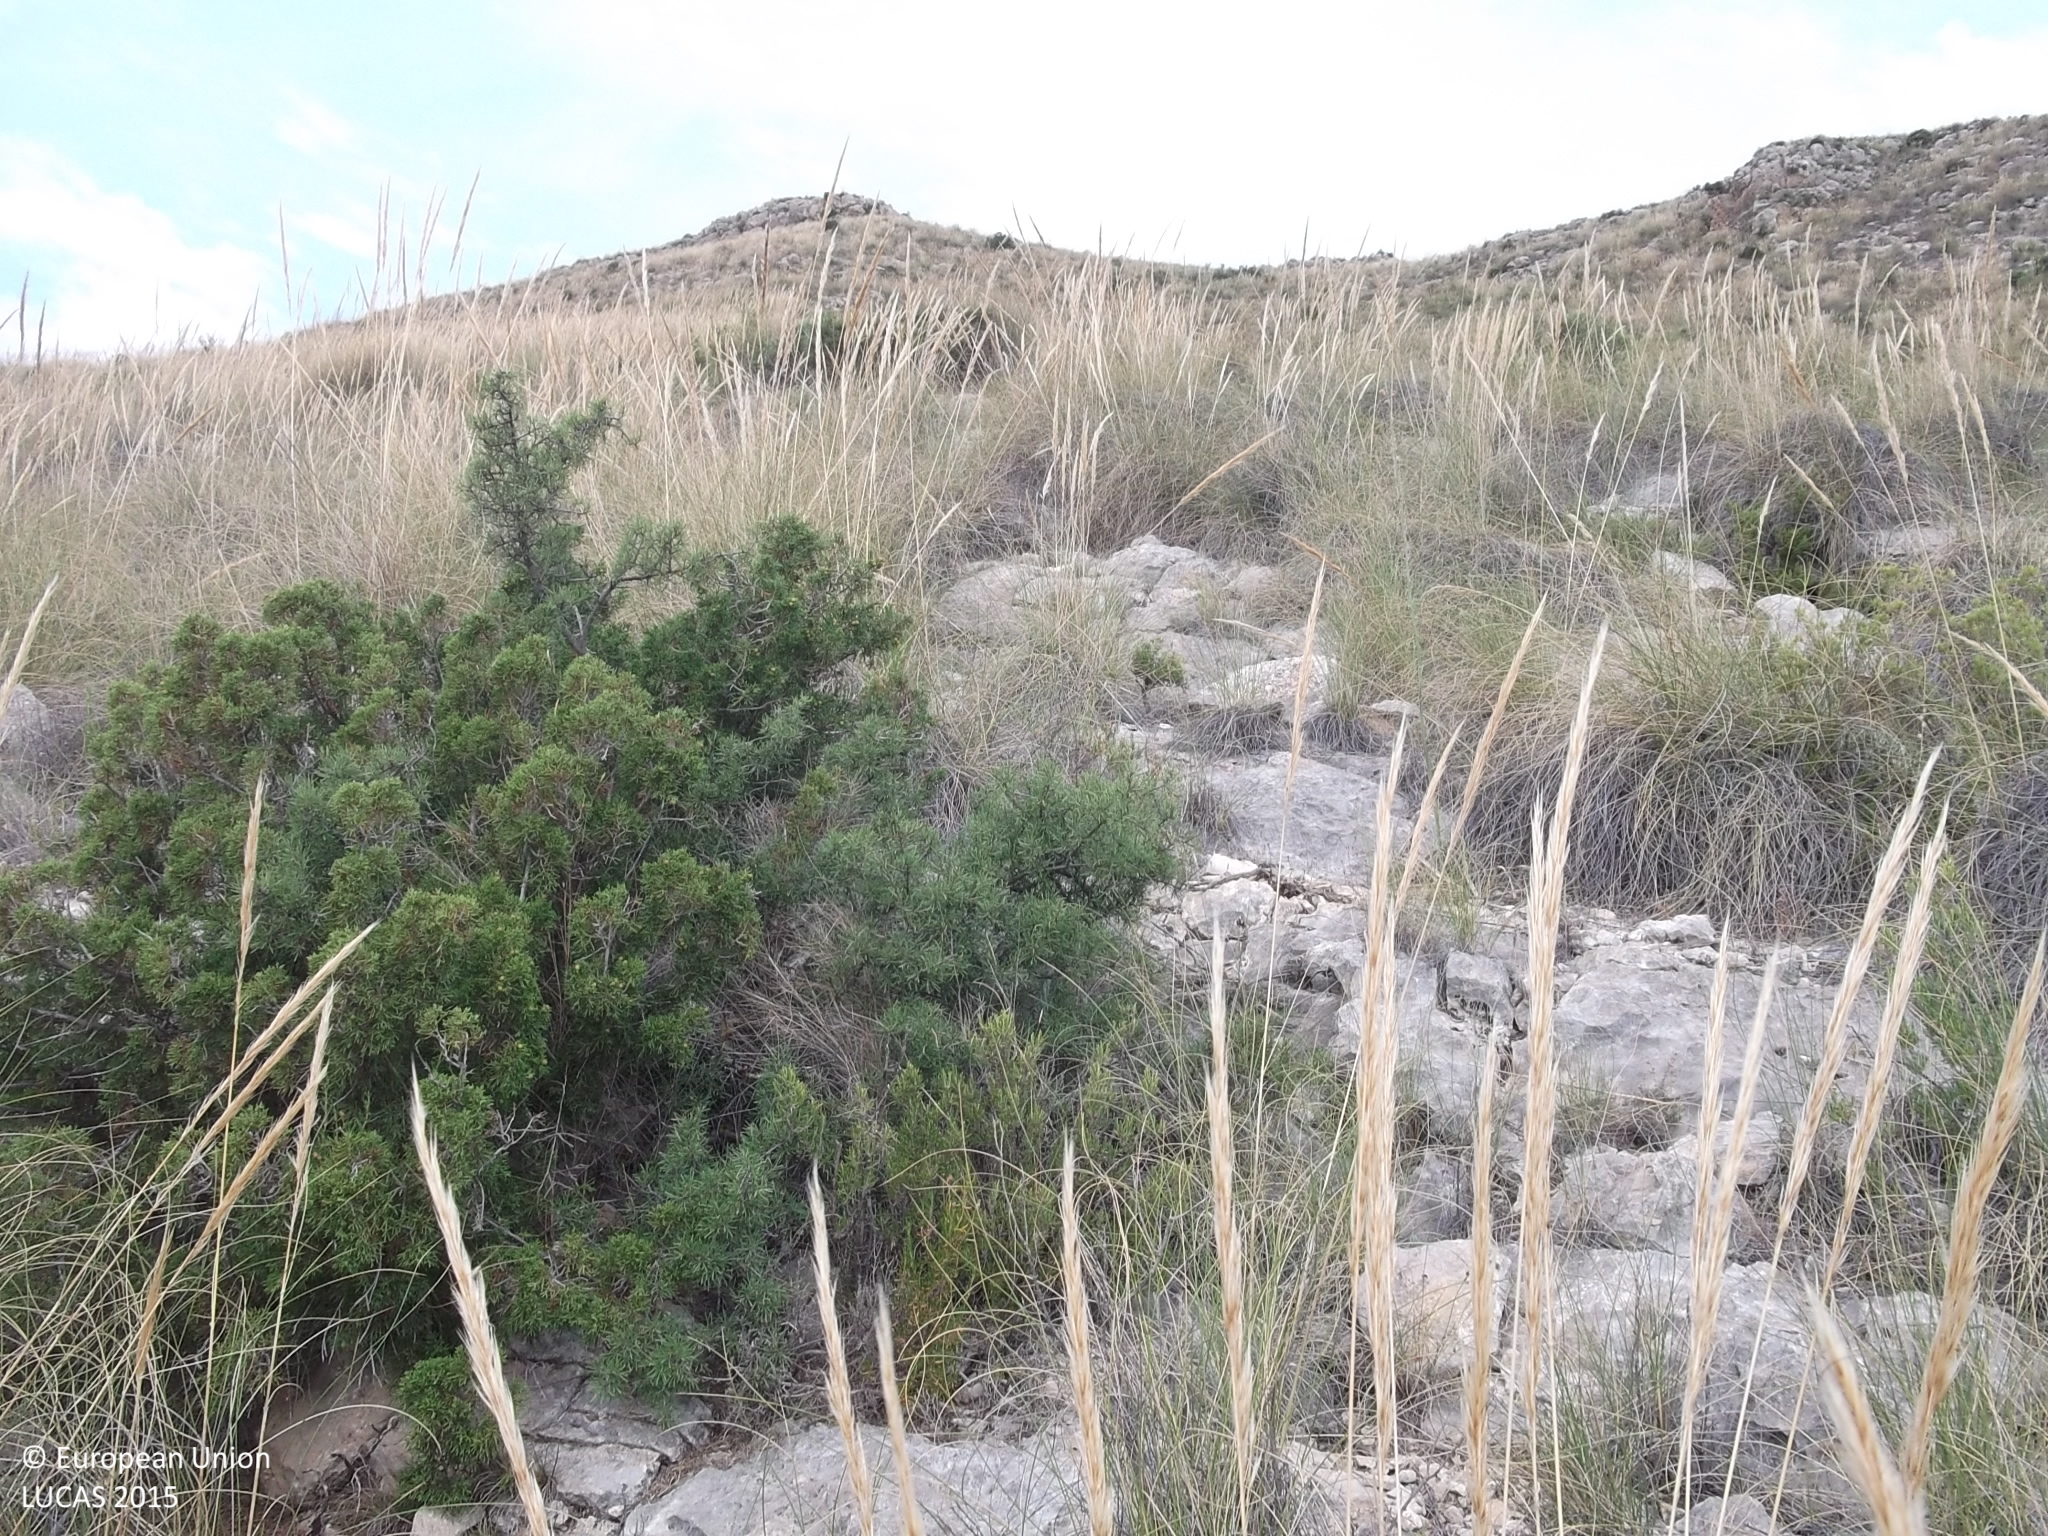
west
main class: Shrubland
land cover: Shrubland without tree cover
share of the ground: 25 - 50 %
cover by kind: consolidated bare surface 40 %, shrubs 30 %, herbaceous plants 30 %
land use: Semi-natural and natural areas not in use
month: May
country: ES
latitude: 38.5071
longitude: -1.3786
